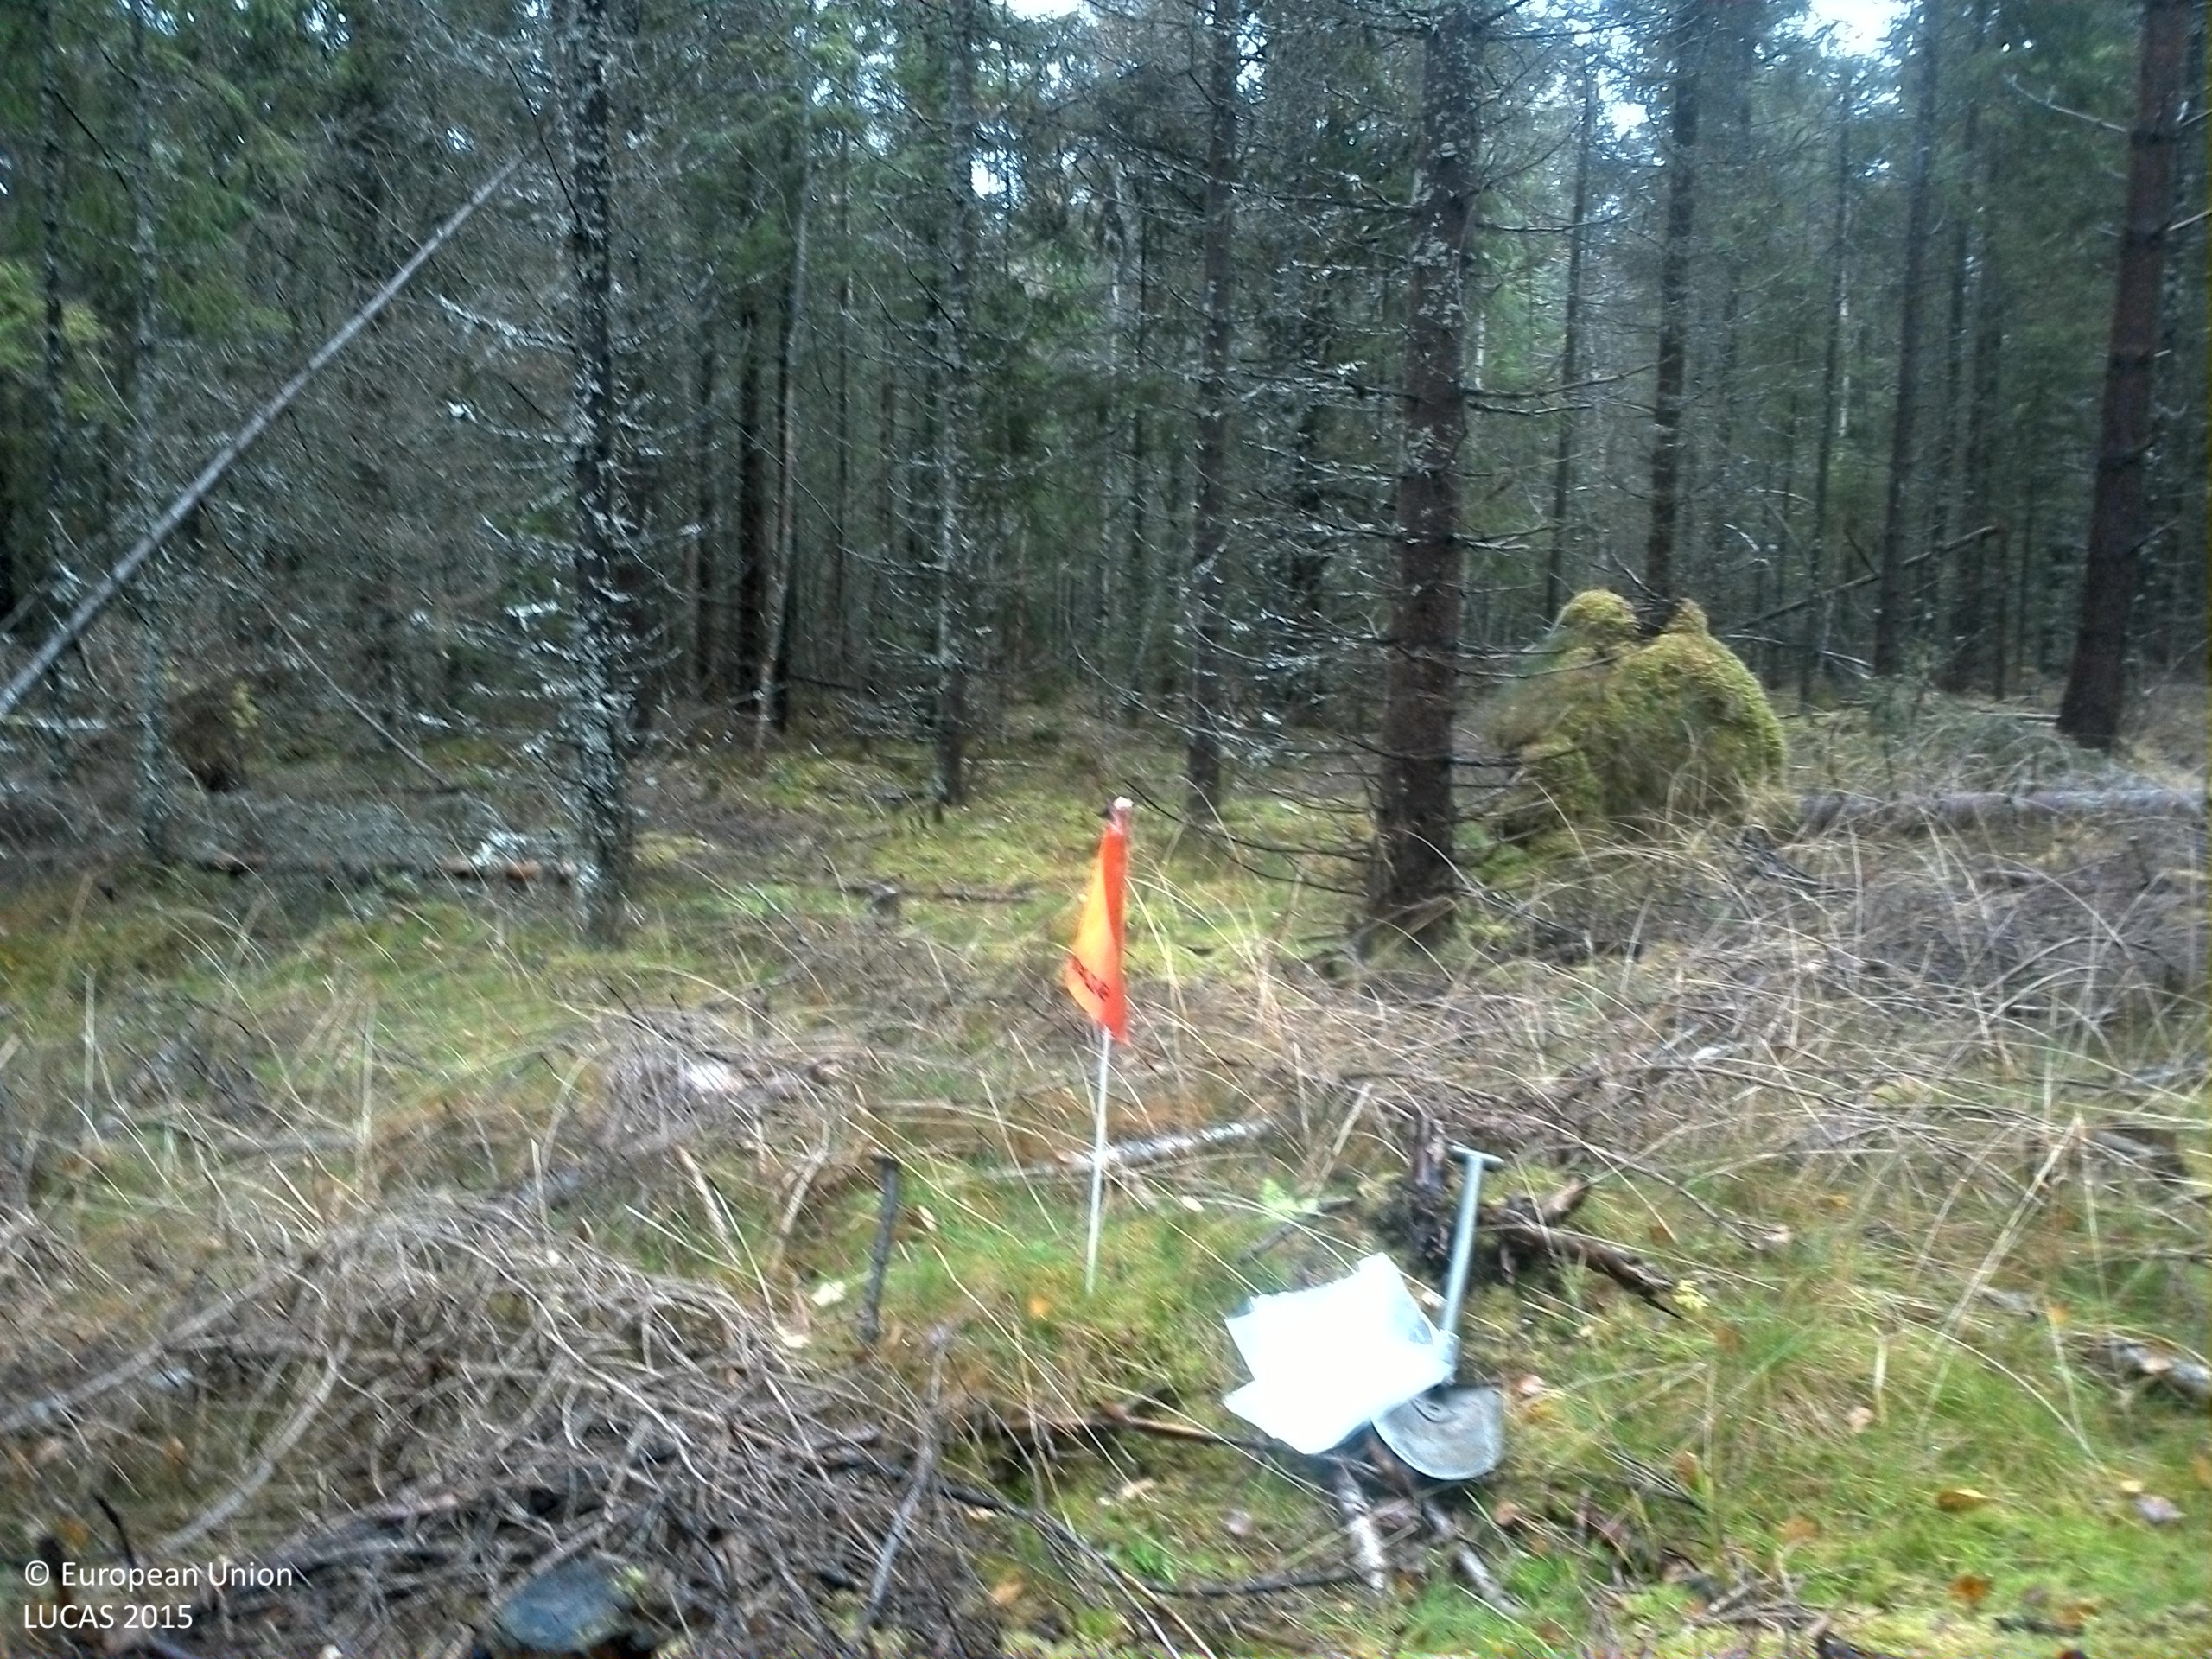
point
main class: Woodland
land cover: Spruce dominated coniferous woodland
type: boreal forest
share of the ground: 50 - 75 %
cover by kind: coniferous forest trees 55 %, shrubs 15 %, herbaceous plants 15 %, lichens and mosses 15 %
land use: Forestry
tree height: > 5 m
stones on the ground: 10 - 25 %
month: October
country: SE
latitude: 59.7714
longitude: 14.8871
